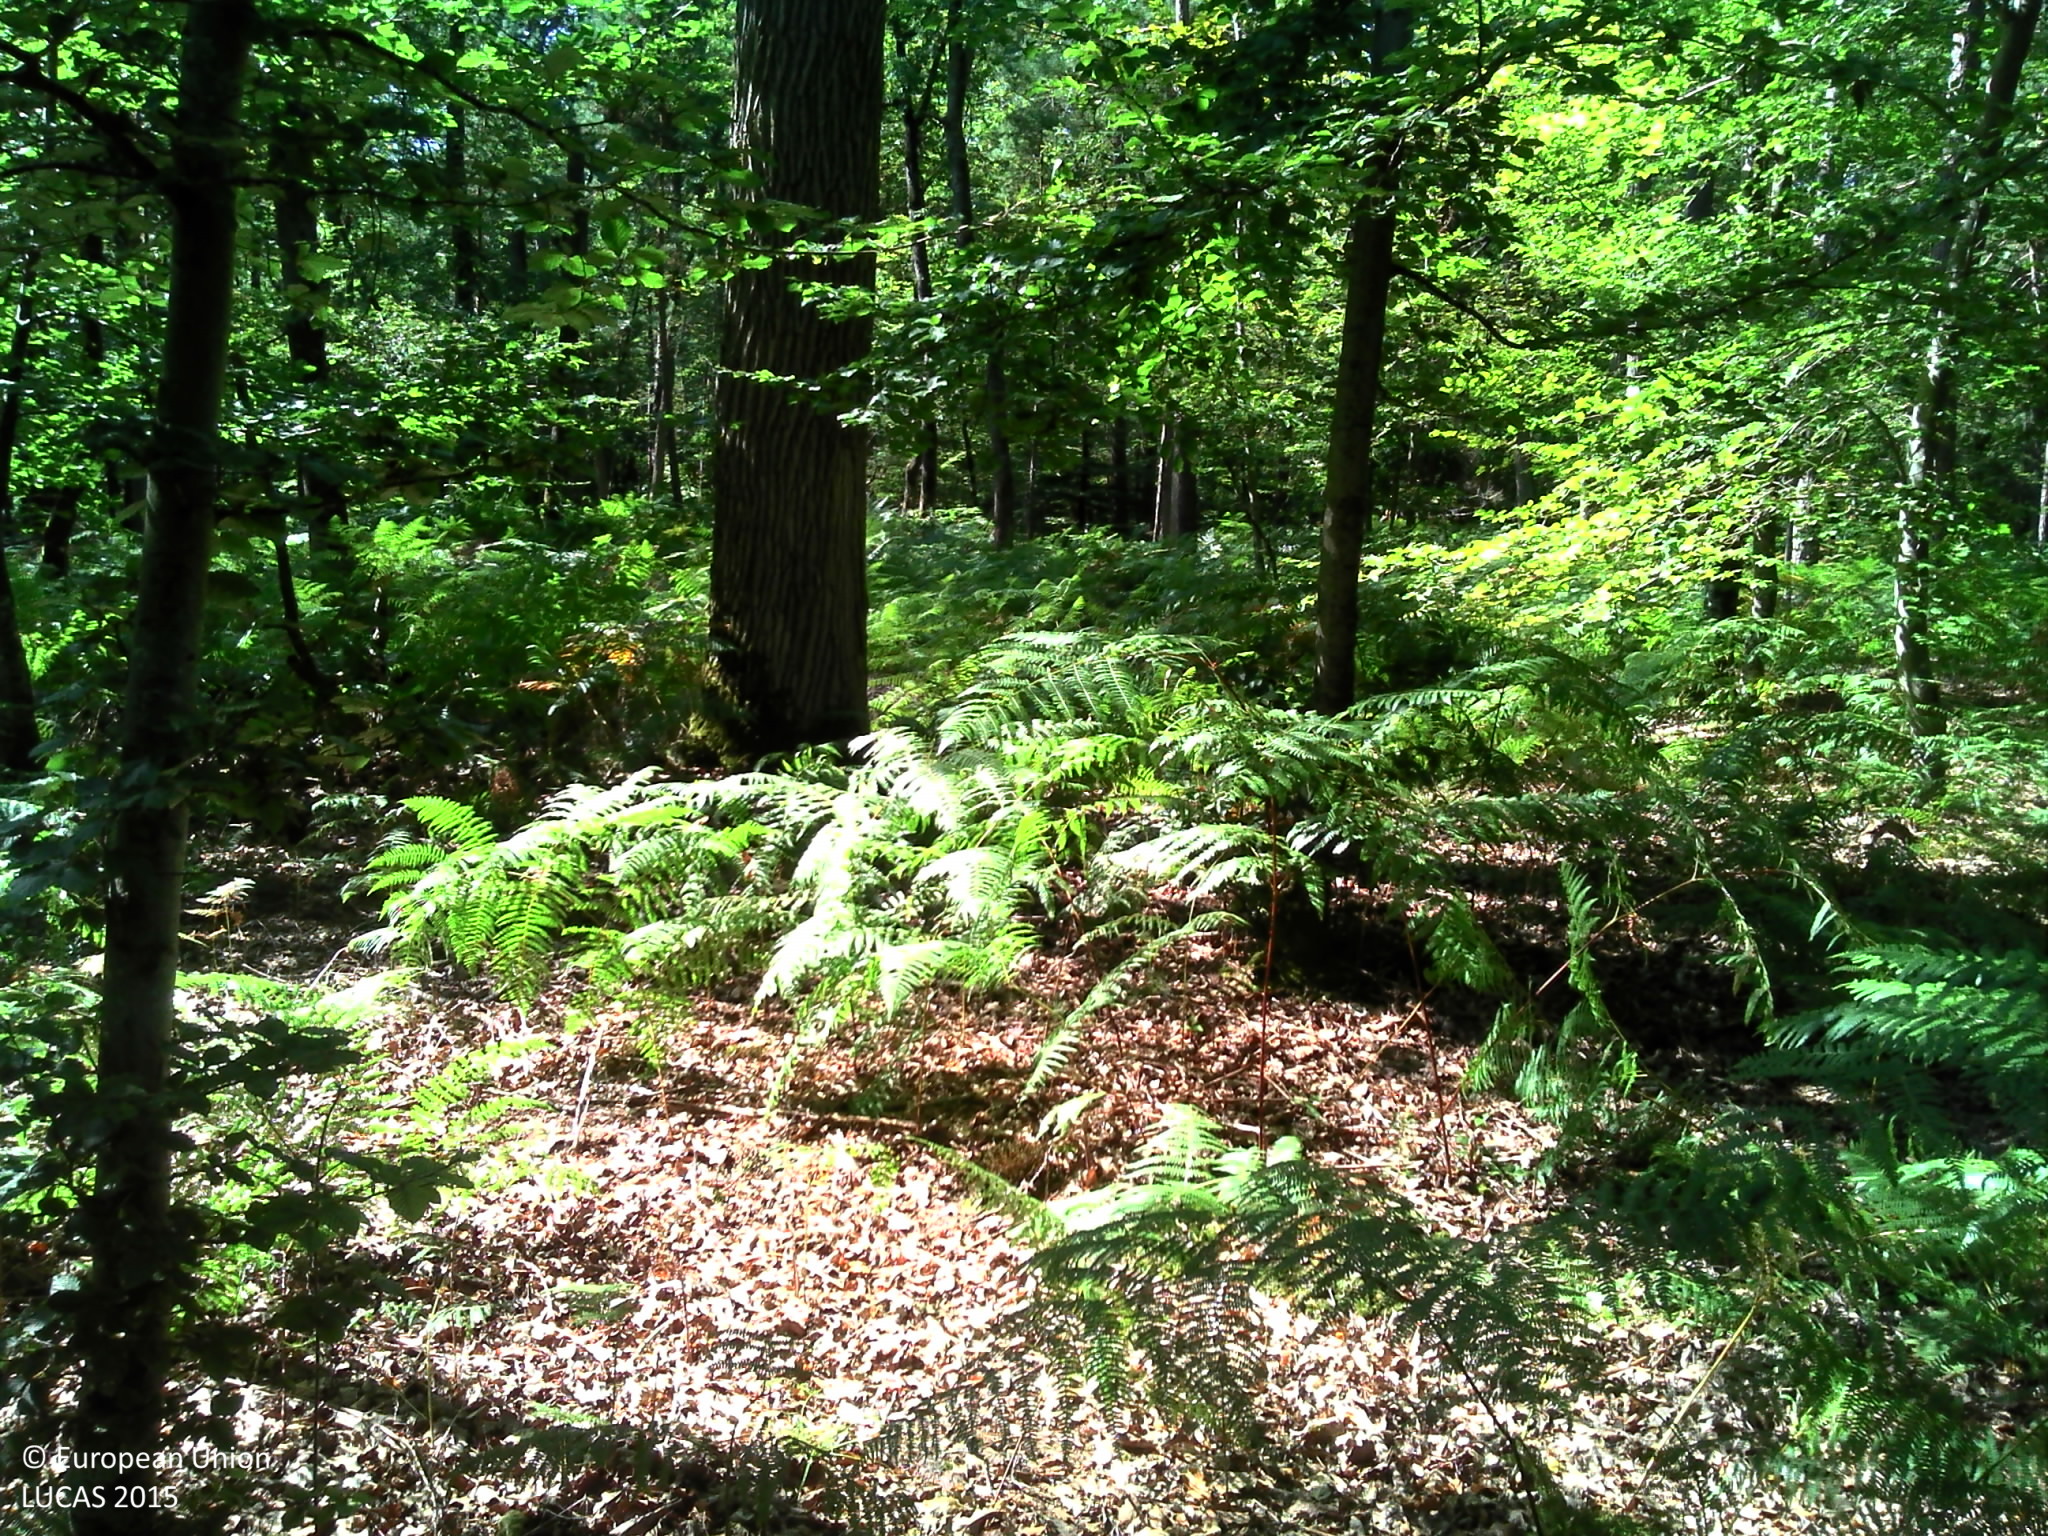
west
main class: Woodland
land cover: Broadleaved woodland
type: beech forest
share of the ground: > 75 %
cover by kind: broadleaved forest trees 75 %, herbaceous plants 10 %, lichens and mosses 10 %, coniferous forest trees 5 %
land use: Forestry
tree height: > 5 m
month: September
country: FR
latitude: 48.3832
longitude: 2.7670
